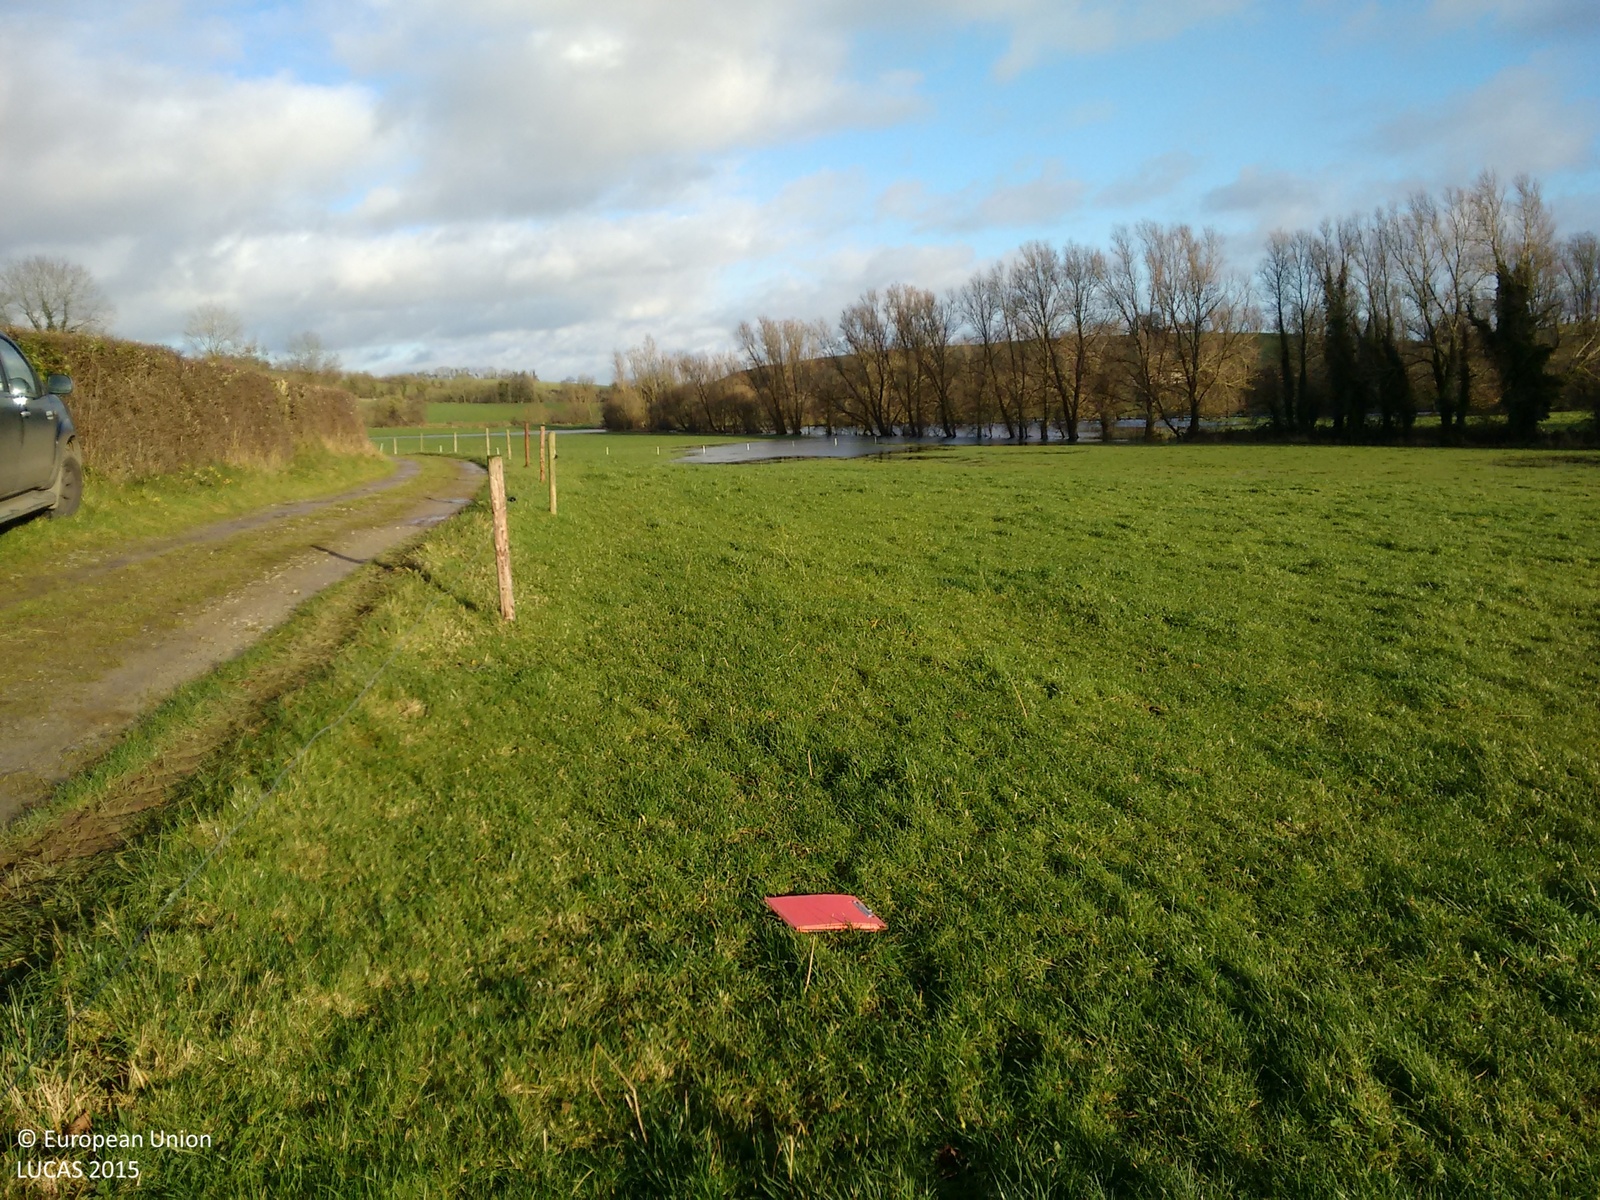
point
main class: Grassland
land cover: Grassland without tree/shrub cover
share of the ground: > 75 %
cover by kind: herbaceous plants 100 %
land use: Agriculture (excluding fallow land and kitchen gardens)
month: December
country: IE
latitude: 53.9068
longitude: -6.6770
